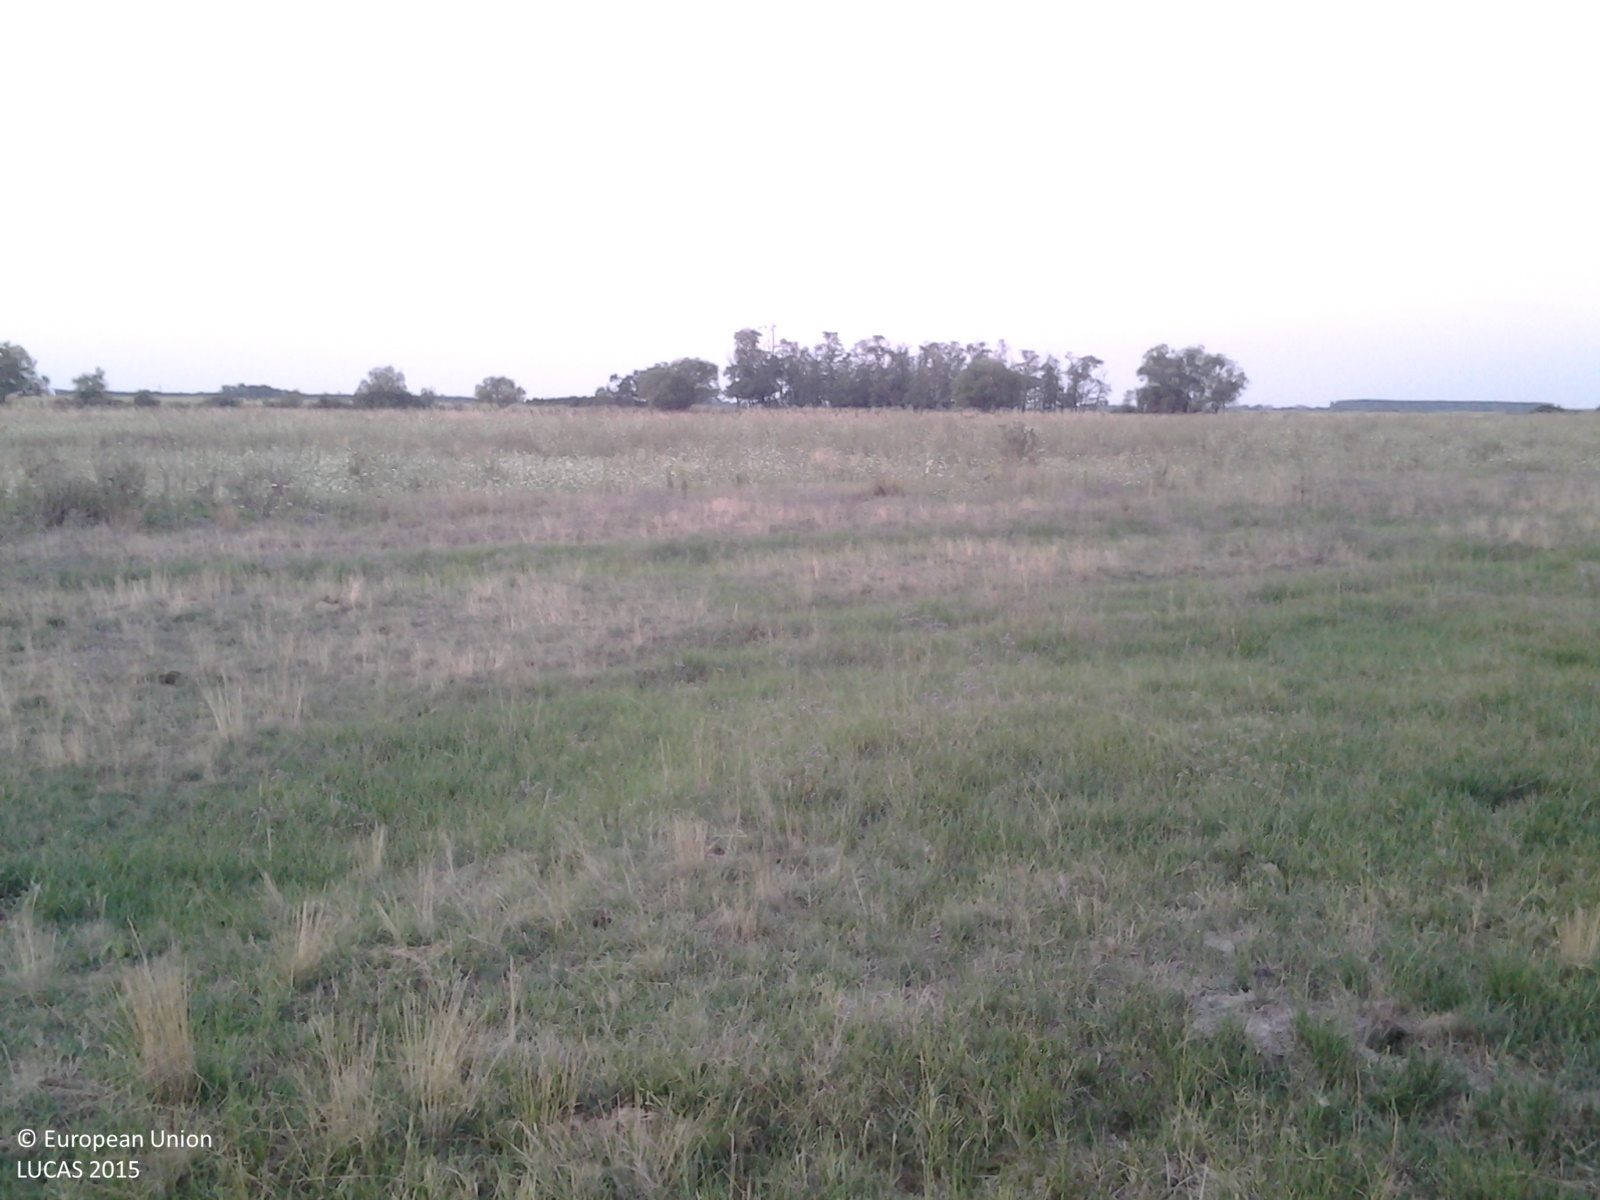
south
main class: Grassland
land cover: Grassland without tree/shrub cover
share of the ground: > 75 %
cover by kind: herbaceous plants 100 %
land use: Agriculture (excluding fallow land and kitchen gardens)
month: August
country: HU
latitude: 46.8571
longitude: 21.4900
